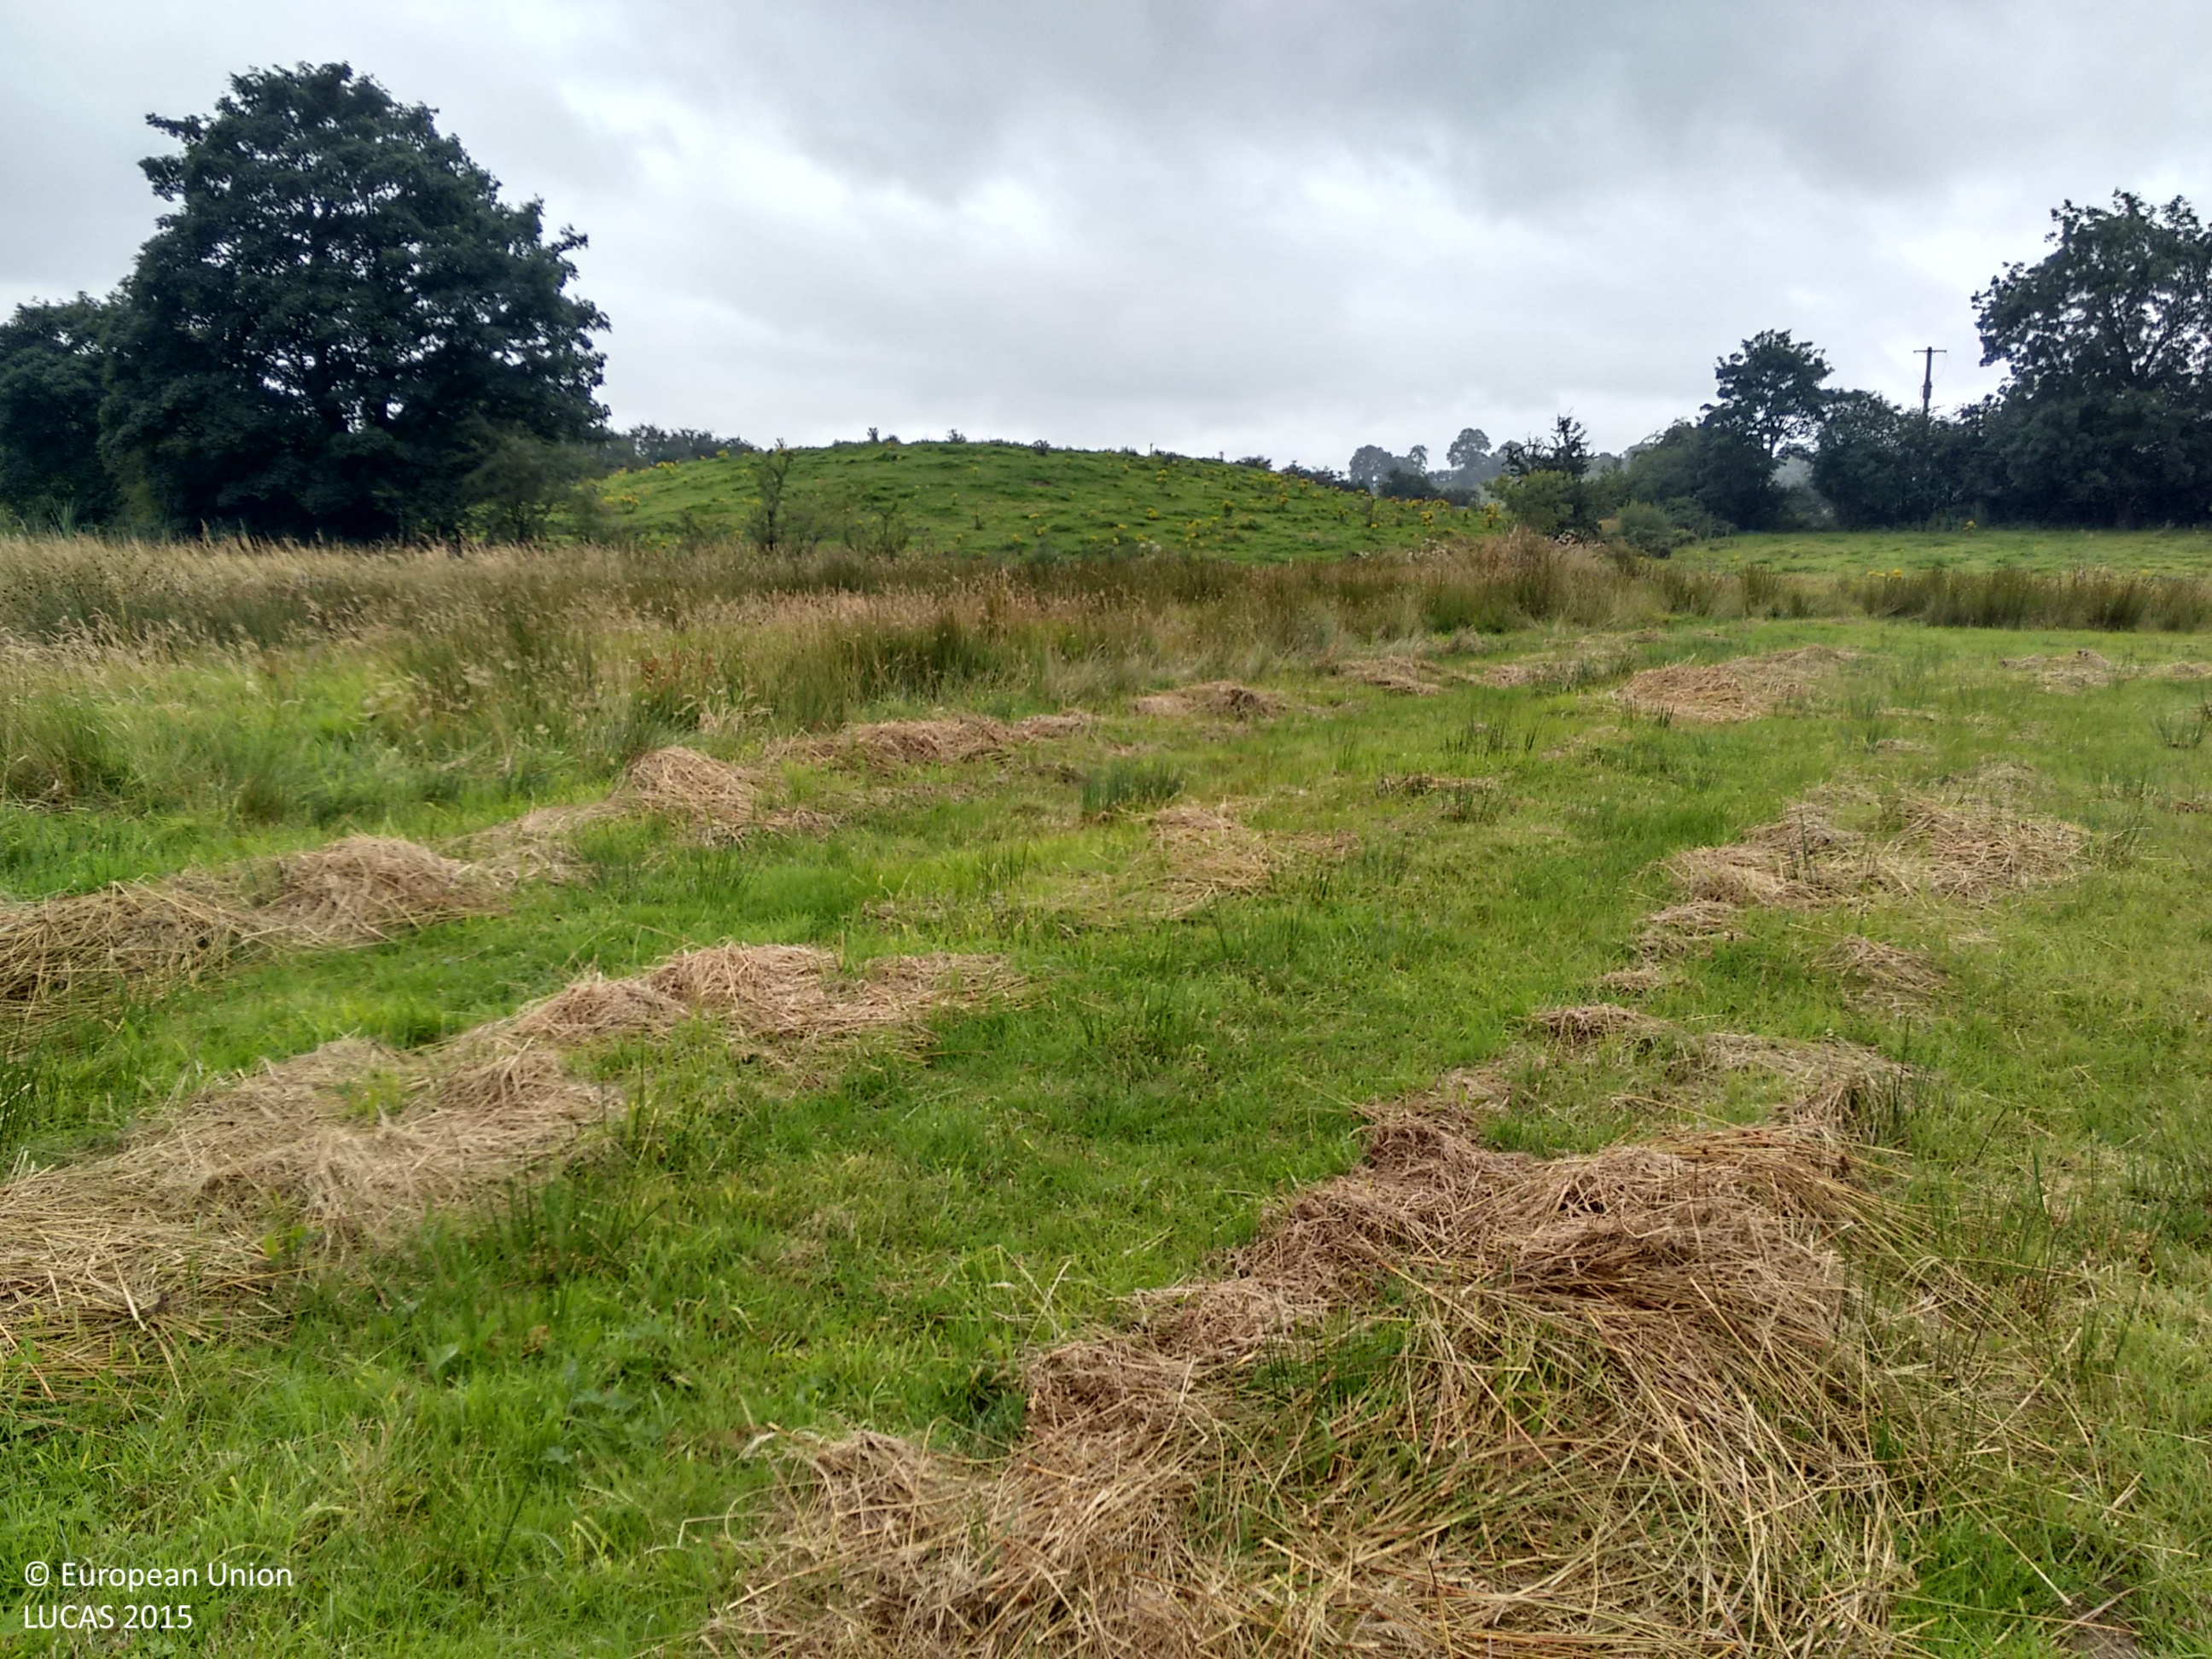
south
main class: Grassland
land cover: Grassland without tree/shrub cover
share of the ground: > 75 %
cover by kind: herbaceous plants 100 %
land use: Agriculture (excluding fallow land and kitchen gardens)
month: August
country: IE
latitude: 54.0553
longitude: -6.8005
